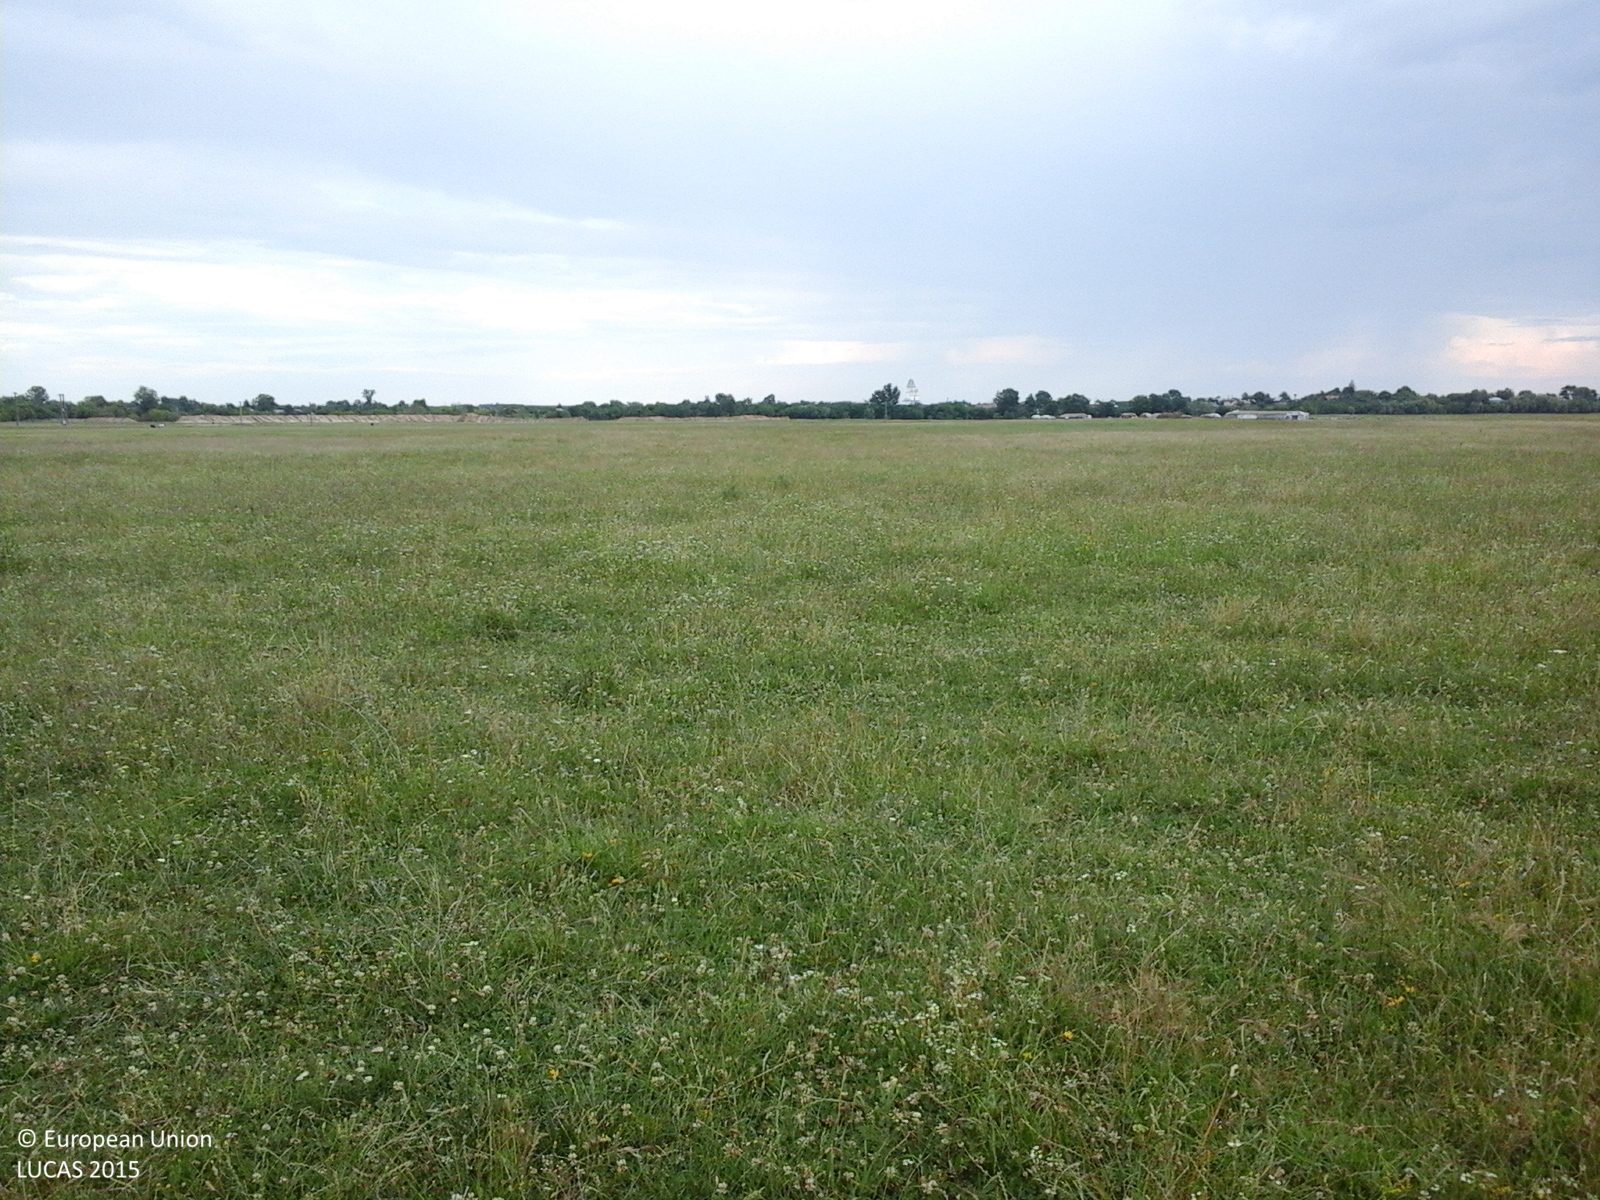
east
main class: Grassland
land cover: Grassland without tree/shrub cover
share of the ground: > 75 %
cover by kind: herbaceous plants 100 %
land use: Agriculture (excluding fallow land and kitchen gardens)
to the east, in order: Grassland without tree/shrub cover; Tracks; Grassland without tree/shrub cover
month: July
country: RO
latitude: 44.3671
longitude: 24.7694
